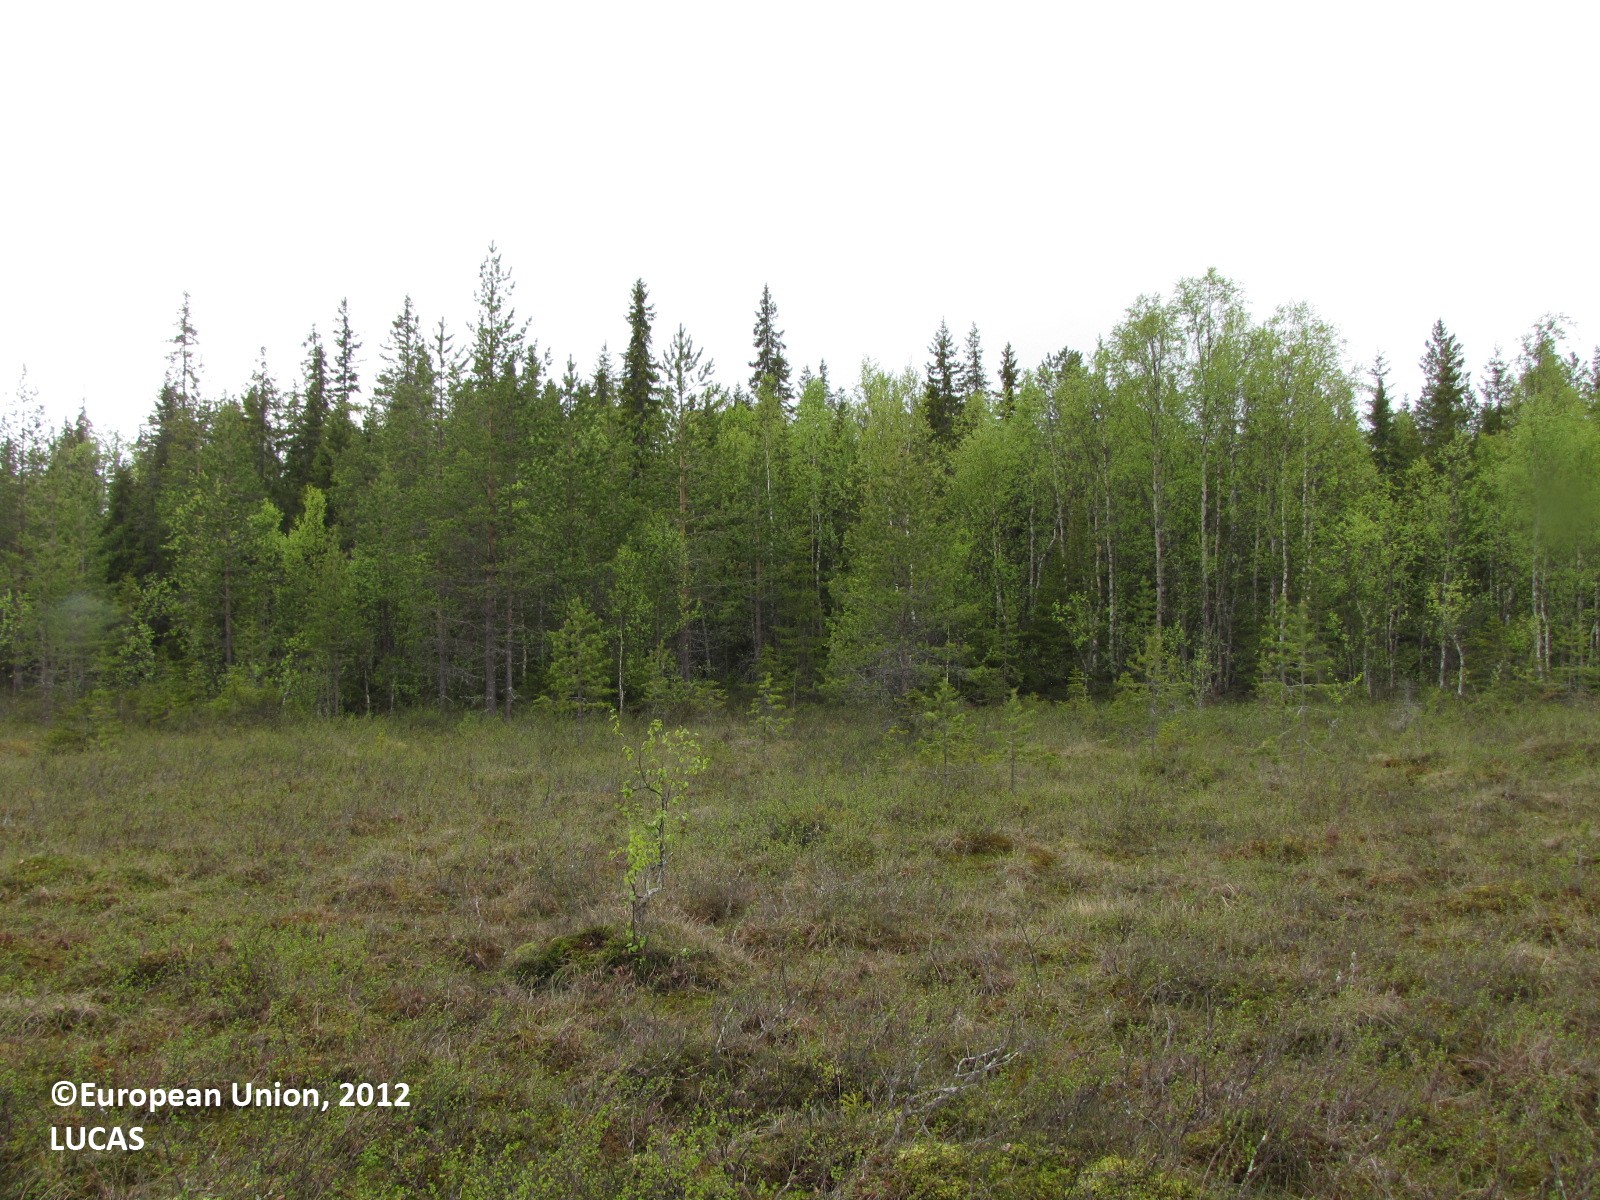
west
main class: Woodland
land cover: Spruce dominated mixed woodland
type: boreal forest
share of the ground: 25 - 50 %
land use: Forestry
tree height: > 5 m
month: June
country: FI
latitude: 65.9153
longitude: 24.7931
